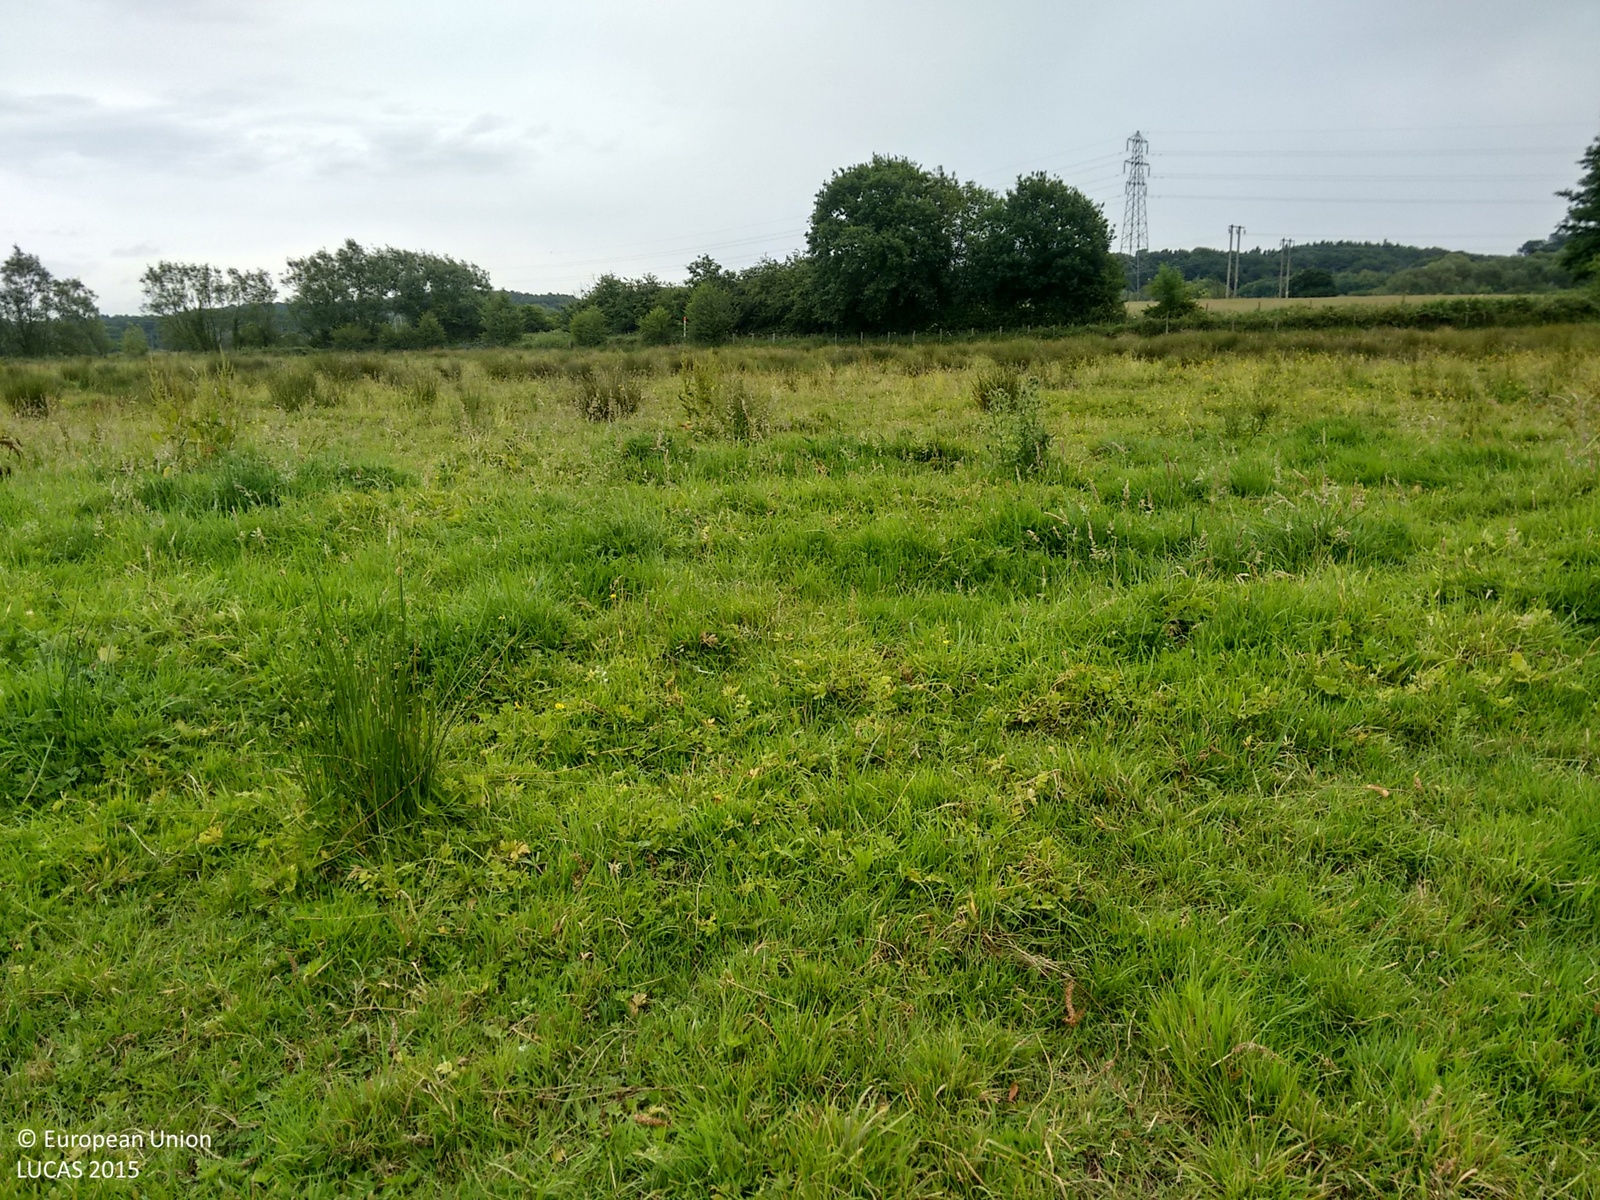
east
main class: Grassland
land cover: Grassland with sparse tree/shrub cover
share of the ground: > 75 %
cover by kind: herbaceous plants 90 %, broadleaved forest trees 5 %, shrubs 5 %
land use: Agriculture (excluding fallow land and kitchen gardens)
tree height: > 5 m
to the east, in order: Grassland with sparse tree/shrub cover; Rivers and streams; Fences; Grassland without tree/shrub cover; Fences; Grass margins; Tracks; Grass margins; Fences; Grassland without tree/shrub cover; Electric lines; Grassland without tree/shrub cover; Electric lines; Grassland without tree/shrub cover; Fences; Spontaneously vegetated surfaces
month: July
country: GB
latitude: 52.3571
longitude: -2.2642
